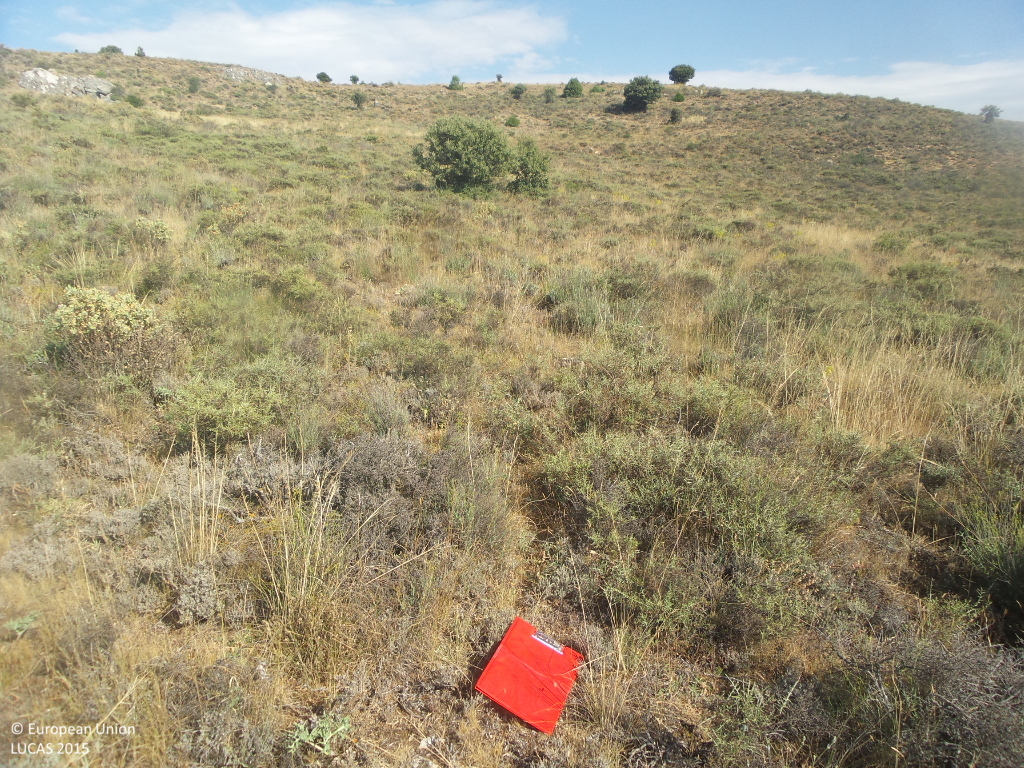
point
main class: Shrubland
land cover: Shrubland without tree cover
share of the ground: 50 - 75 %
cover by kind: shrubs 60 %, herbaceous plants 20 %, lichens and mosses 10 %, unconsolidated bare surface 10 %
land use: Semi-natural and natural areas not in use
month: July
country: ES
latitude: 41.1298
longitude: -2.7683
